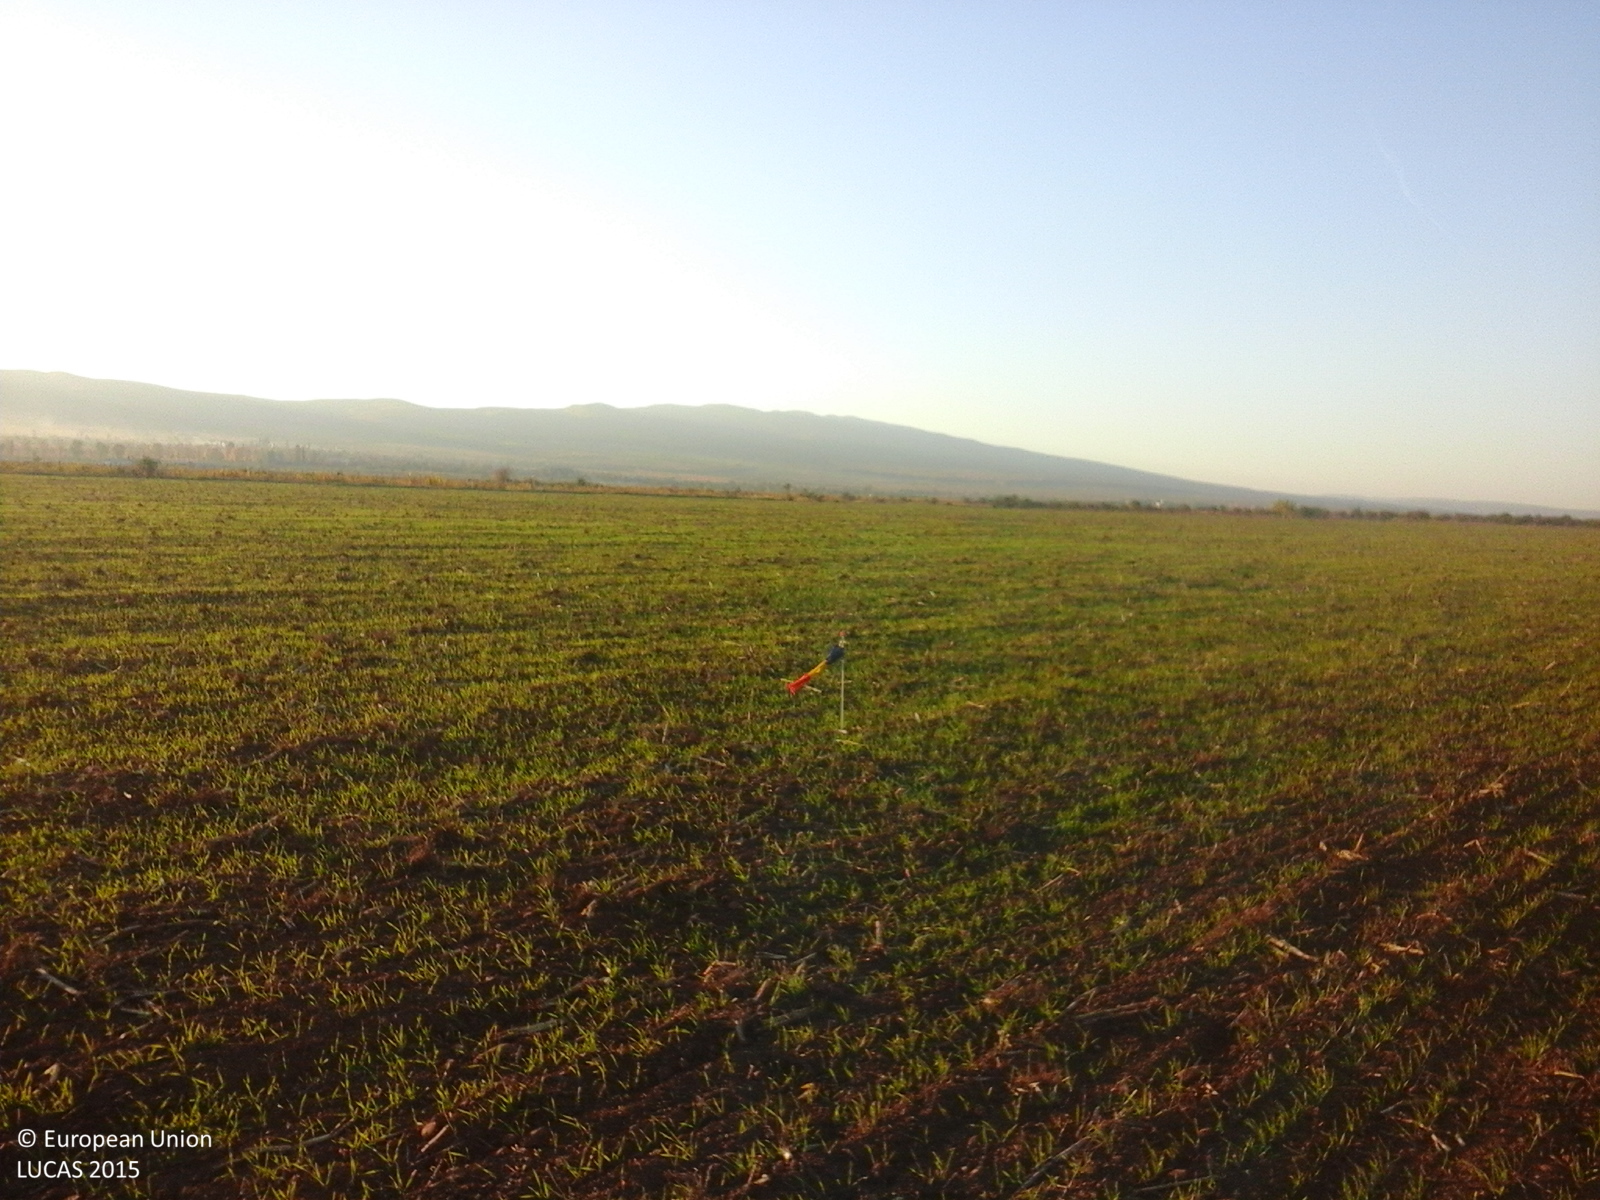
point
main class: Cropland
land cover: Common wheat
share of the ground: 10 - 25 %
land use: Agriculture (excluding fallow land and kitchen gardens)
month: October
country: RO
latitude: 45.7869
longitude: 27.1114
